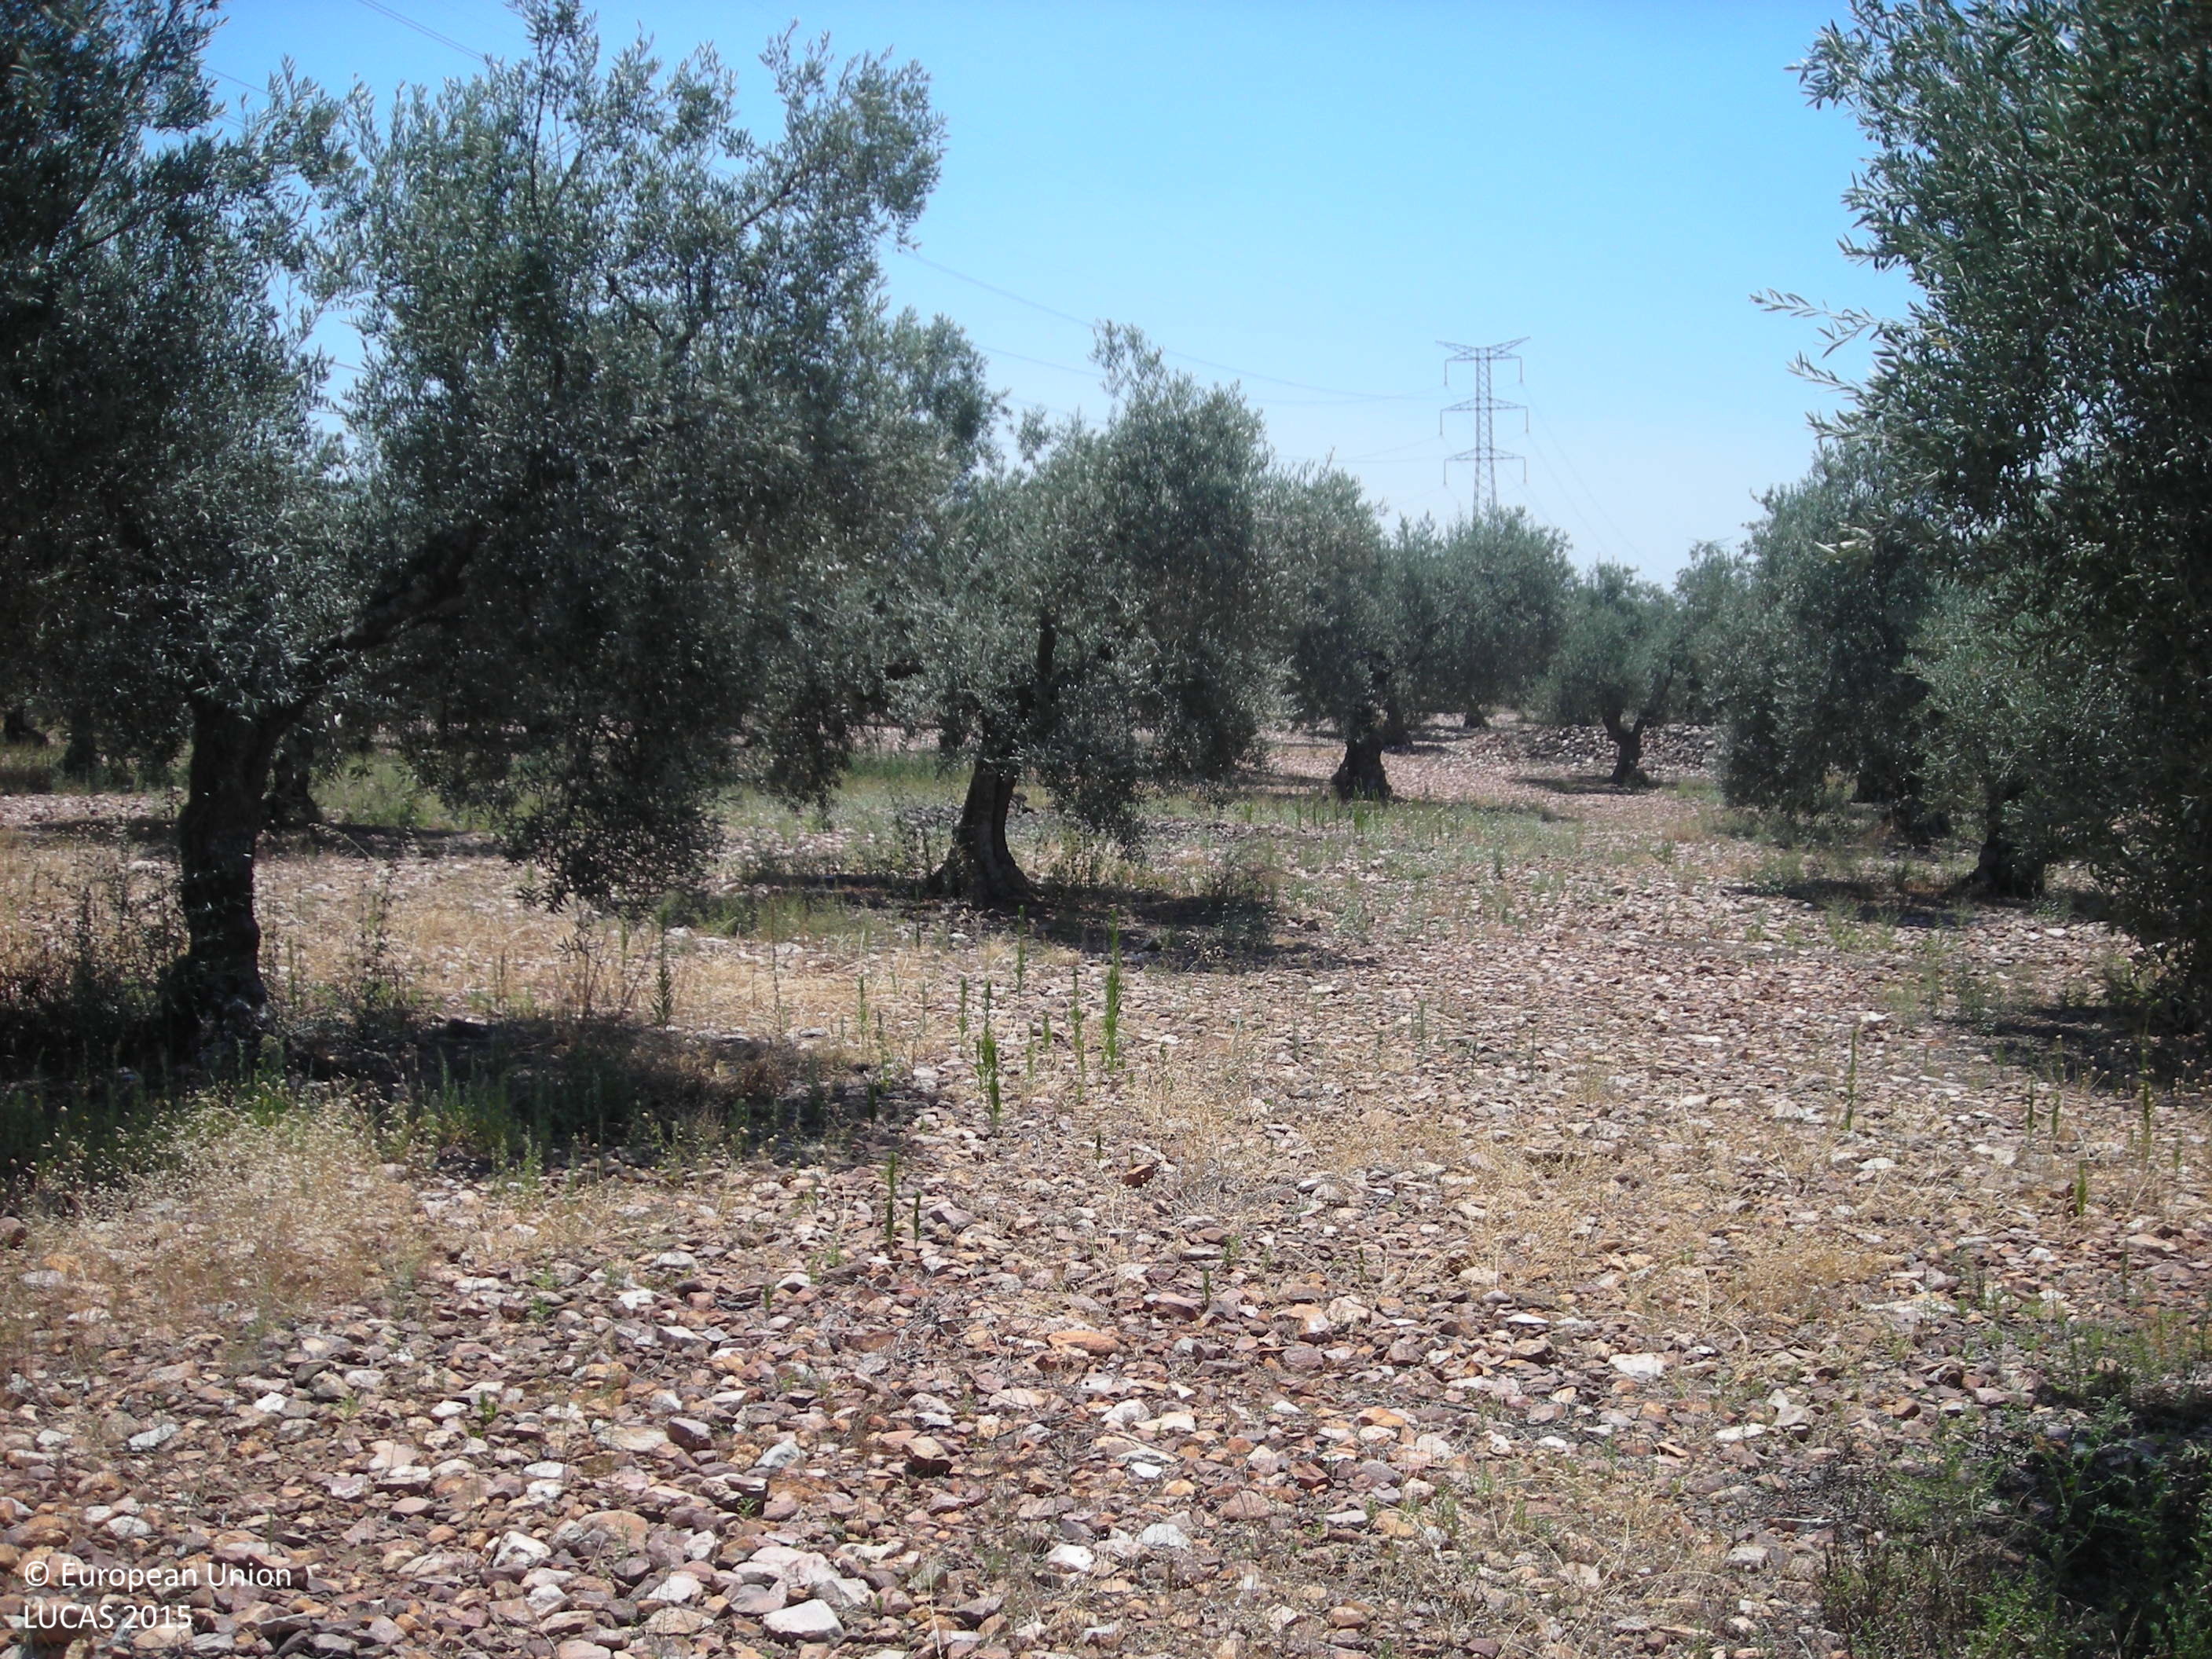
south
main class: Cropland
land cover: Olive groves
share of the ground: 50 - 75 %
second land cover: Grassland without tree/shrub cover
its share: 50 - 75 %
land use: Agriculture (excluding fallow land and kitchen gardens)
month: June
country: ES
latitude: 39.0784
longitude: -5.5236
